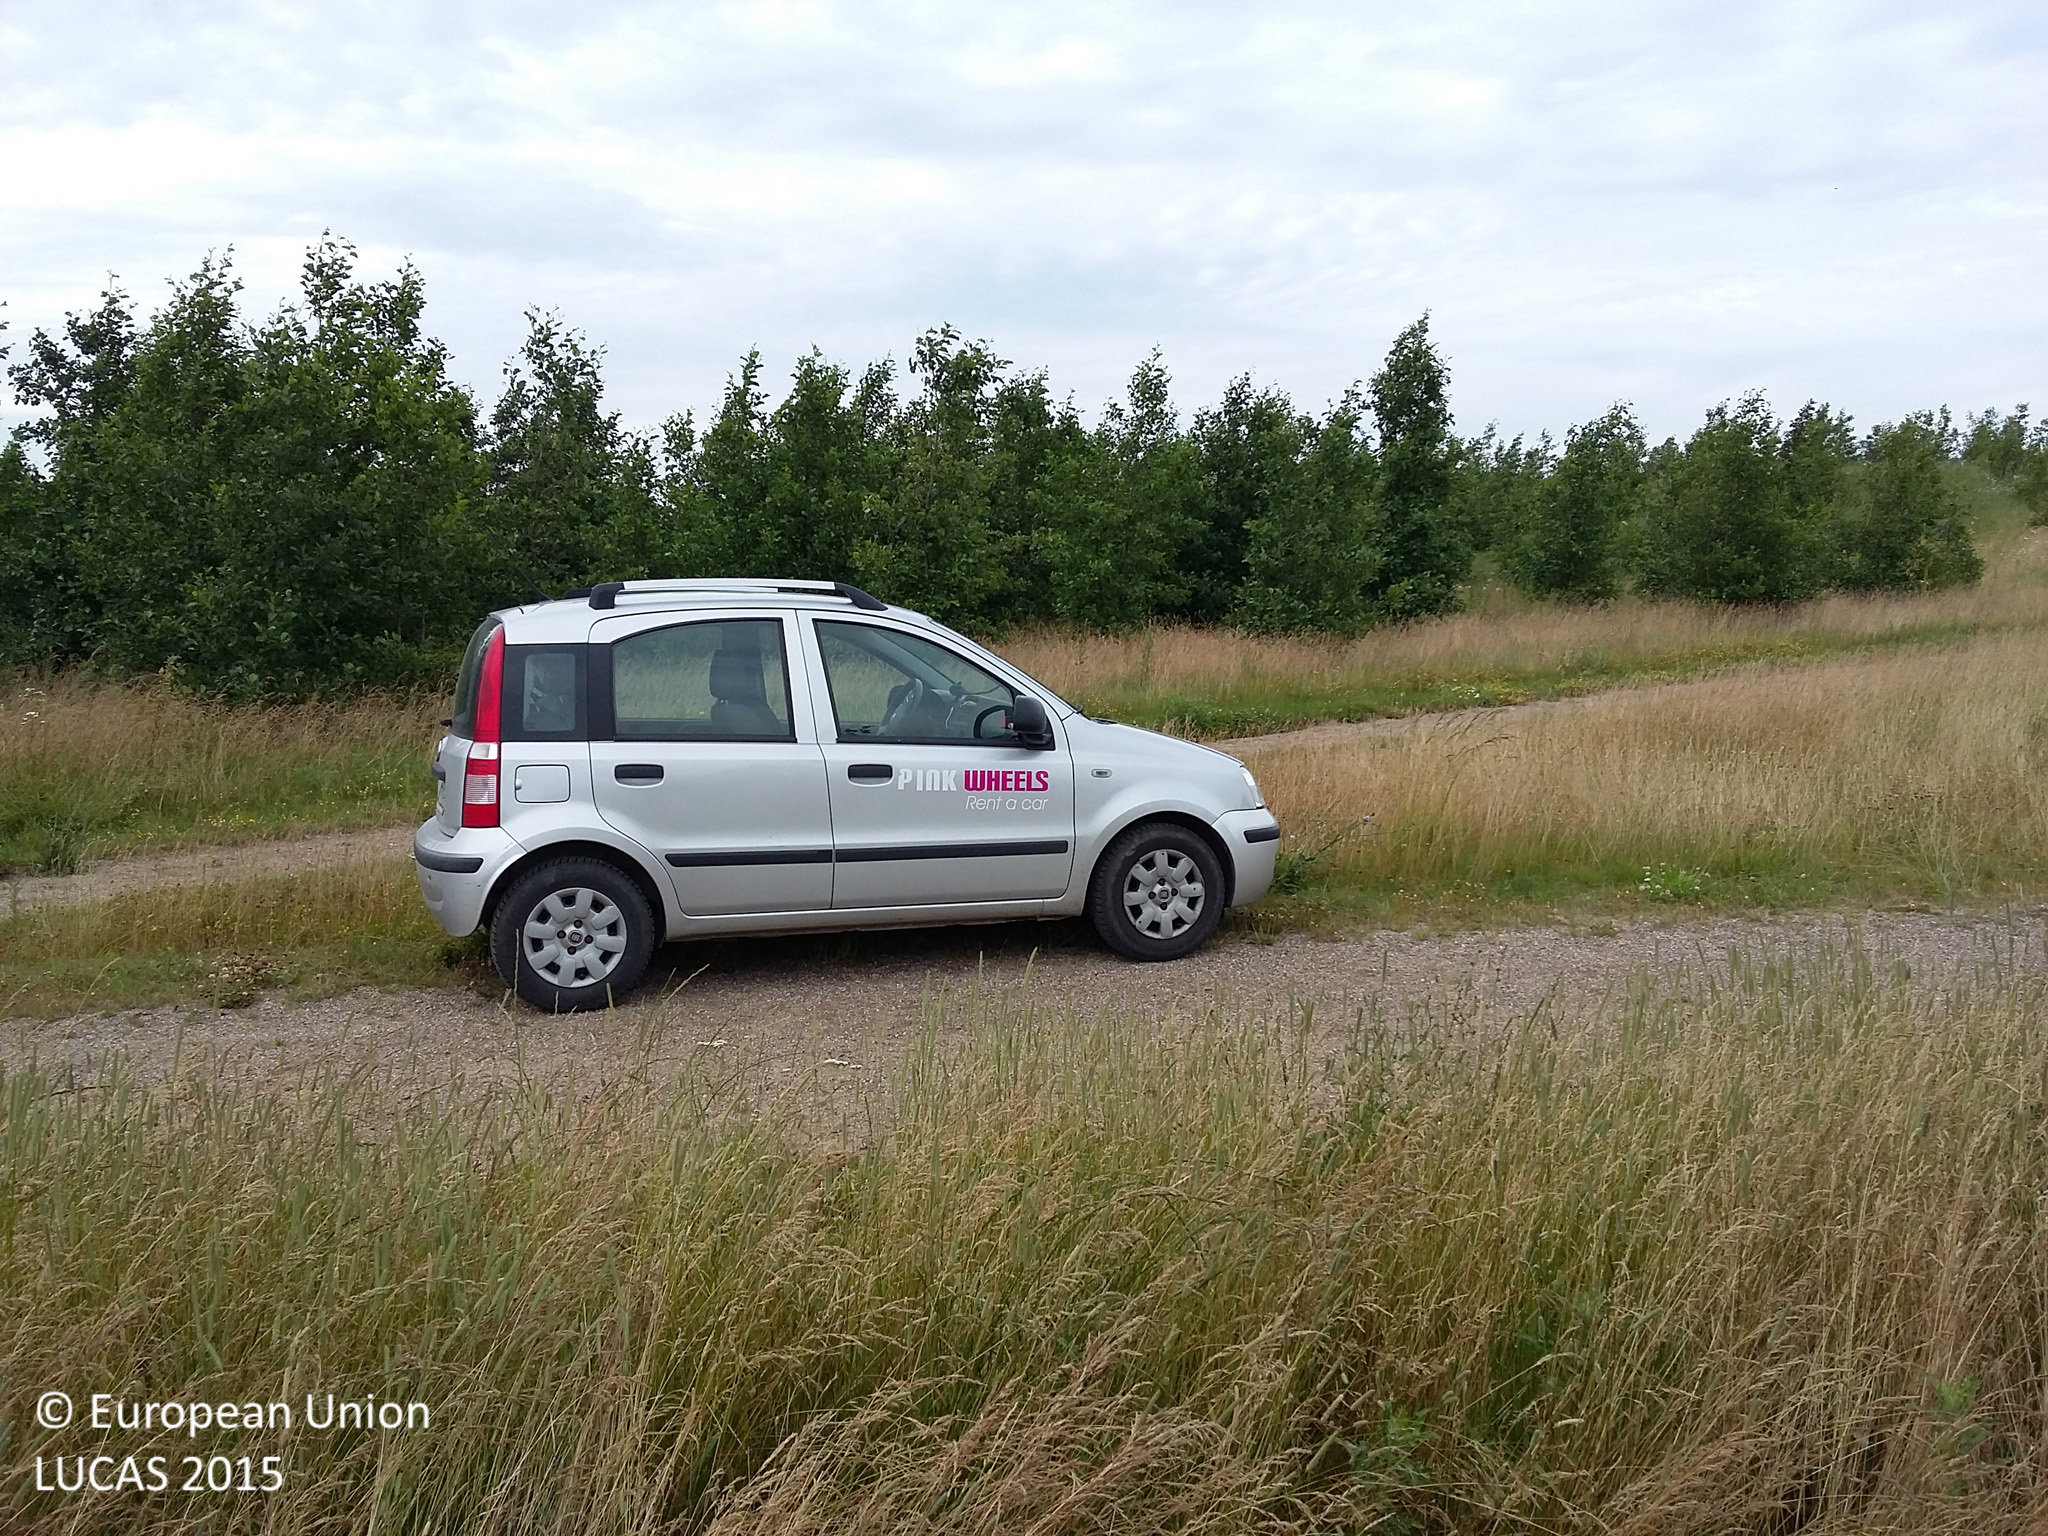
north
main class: Woodland
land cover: Broadleaved woodland
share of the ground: 25 - 50 %
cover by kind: herbaceous plants 65 %, broadleaved forest trees 35 %
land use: Agriculture (excluding fallow land and kitchen gardens)
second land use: Amenities, museums, leisure
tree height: < 5 m
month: July
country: DK
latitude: 55.5338
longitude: 11.3139
